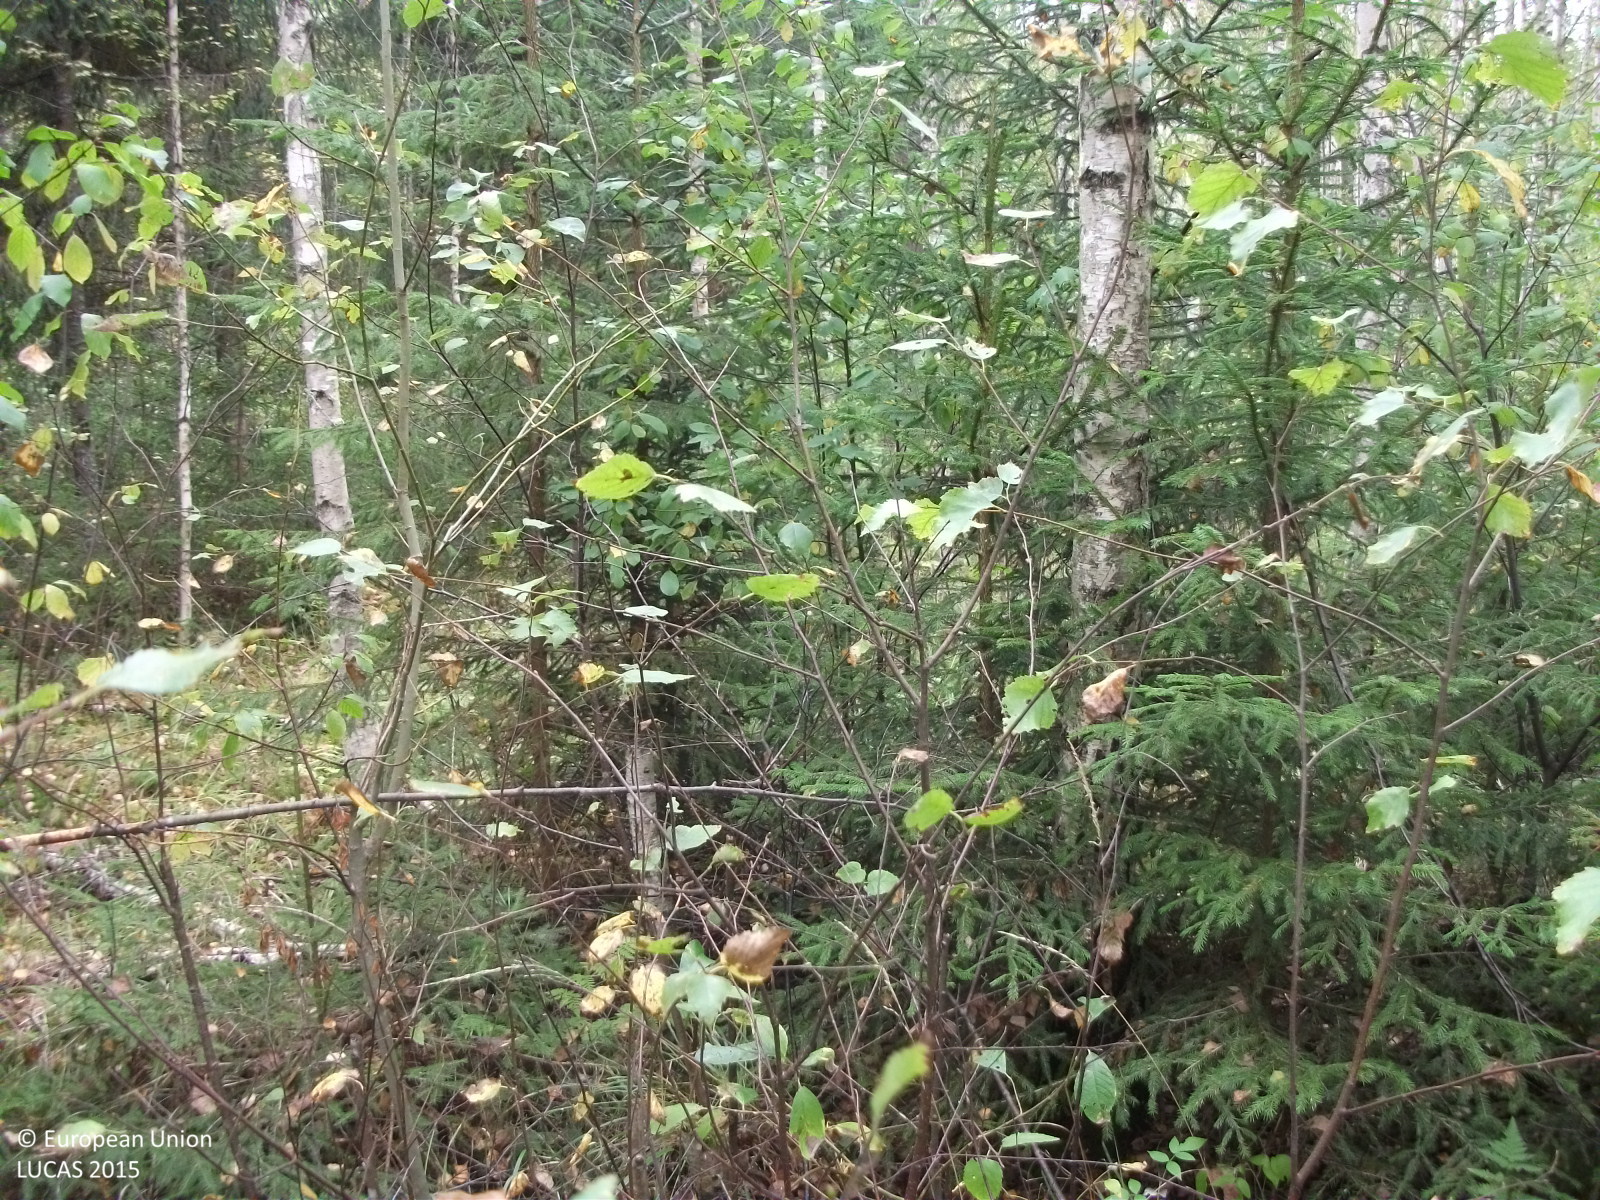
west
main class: Woodland
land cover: Spruce dominated mixed woodland
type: hemiboreal forest and nemoral coniferous forest and mixed broadleaved-coniferous forest
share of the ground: > 75 %
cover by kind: broadleaved forest trees 50 %, coniferous forest trees 30 %, herbaceous plants 10 %, shrubs 5 %, unconsolidated bare surface 5 %
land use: Forestry
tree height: > 5 m
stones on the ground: < 10 %
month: September
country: LV
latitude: 57.7424
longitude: 24.7953
